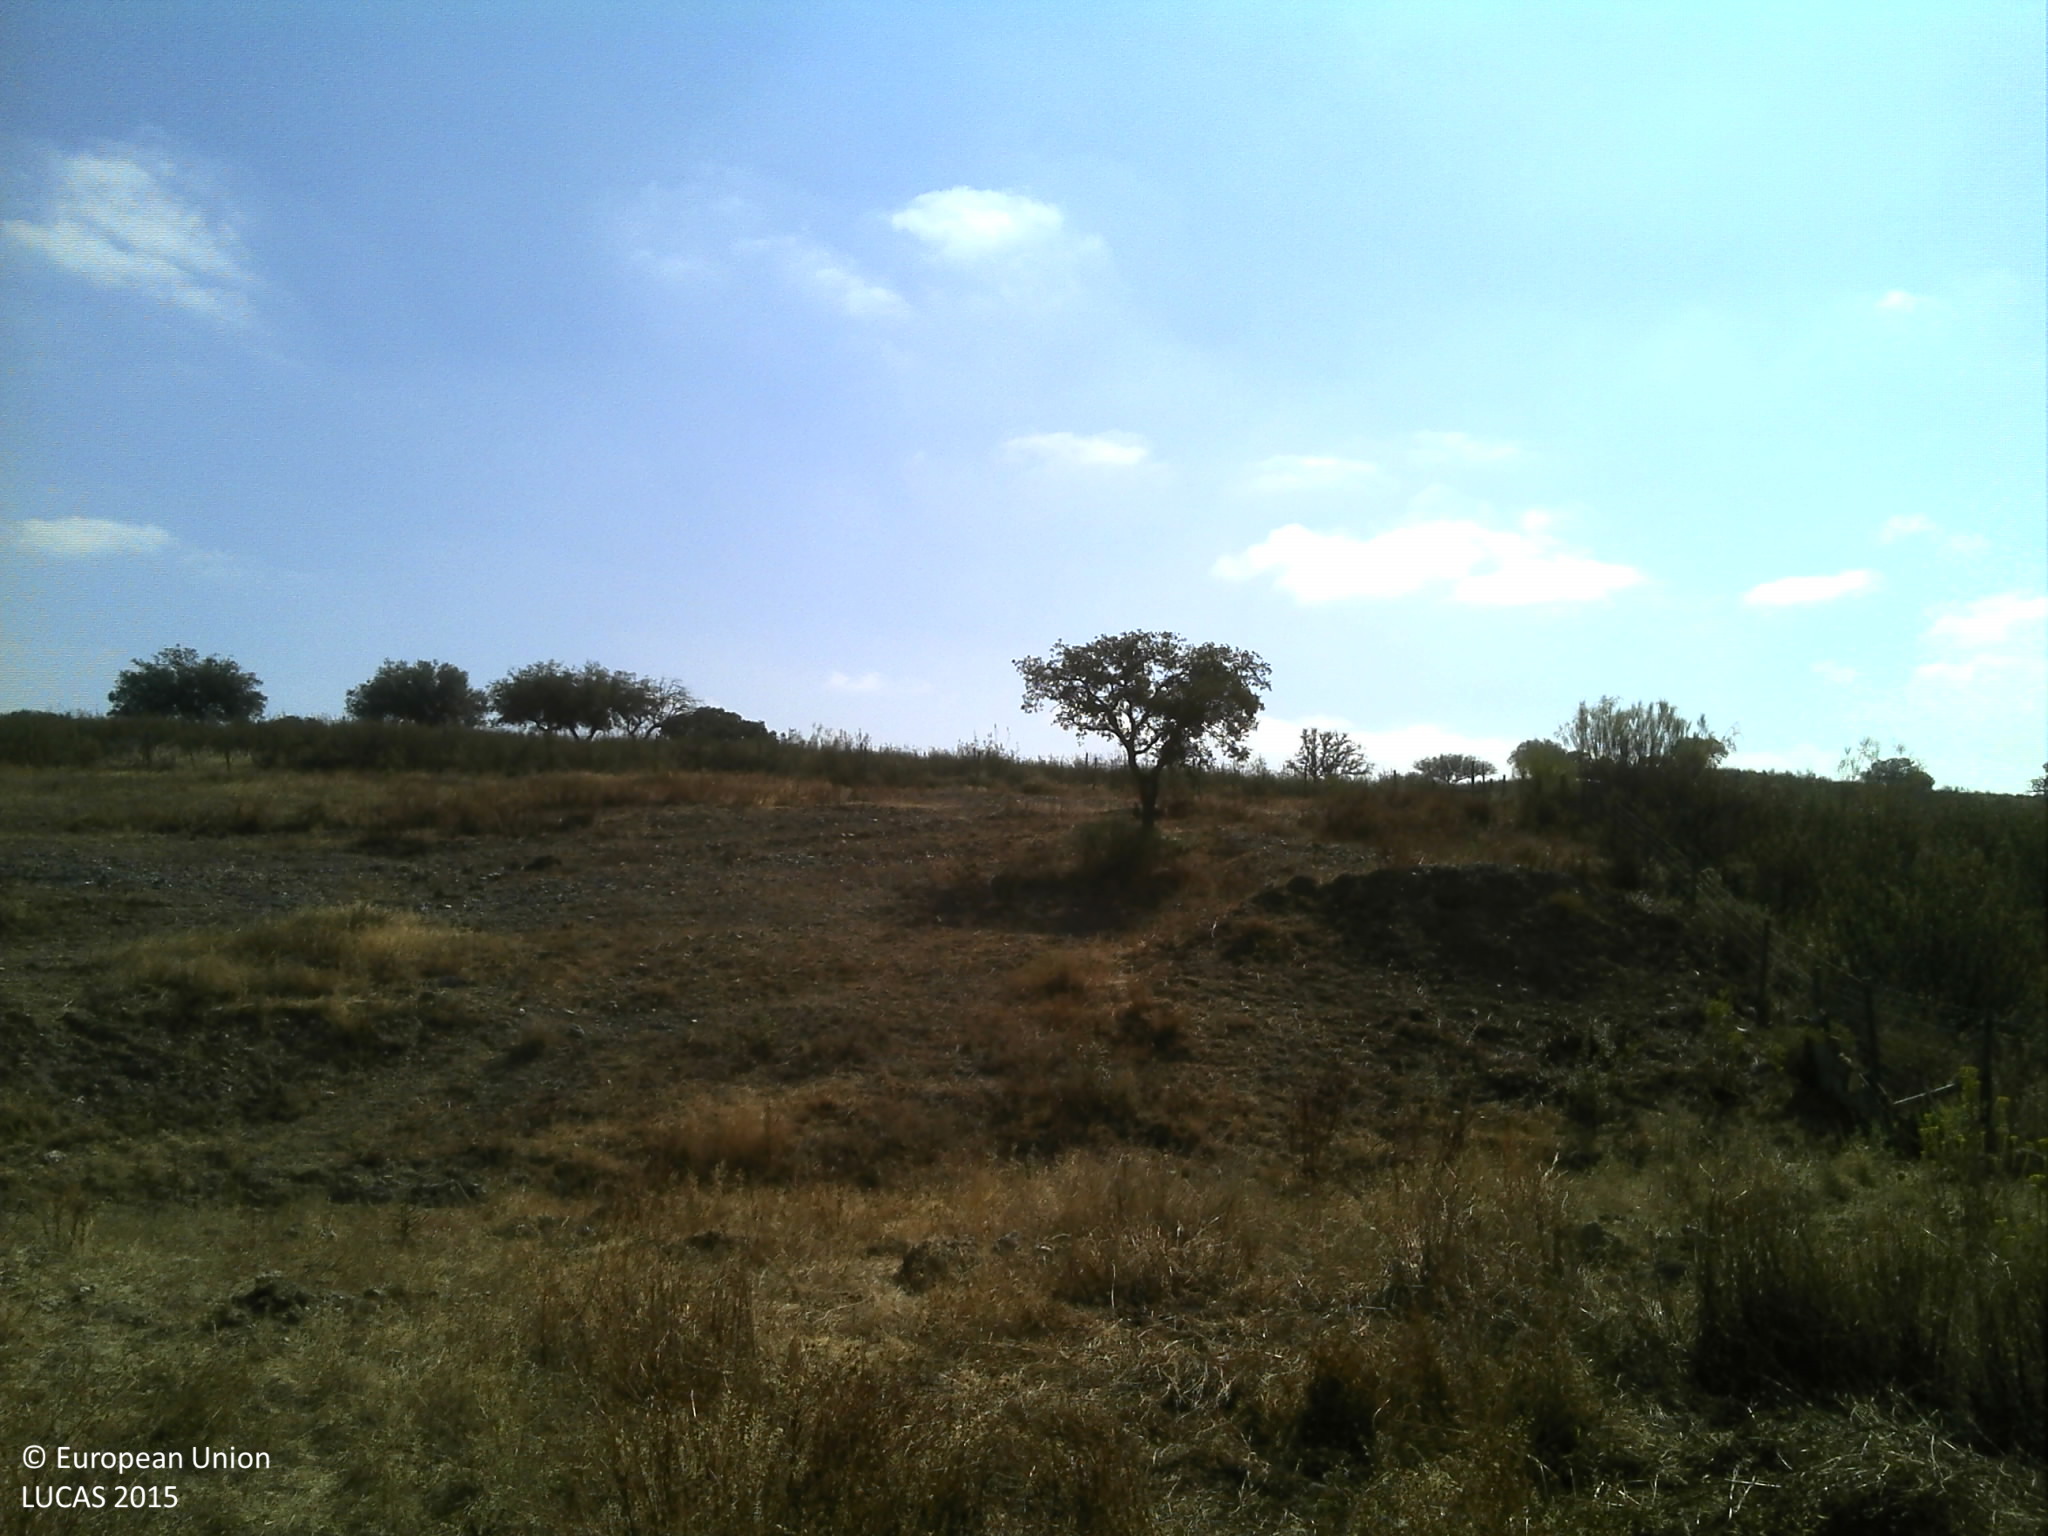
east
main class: Grassland
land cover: Grassland without tree/shrub cover
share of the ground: 25 - 50 %
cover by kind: unconsolidated bare surface 60 %, herbaceous plants 40 %
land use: Agriculture (excluding fallow land and kitchen gardens)
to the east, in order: Grassland without tree/shrub cover; Fences; Grassland without tree/shrub cover; Rivers and streams; Shrubland with sparse tree cover; Tracks; Shrubland with sparse tree cover; Fences; Shrubland without tree cover; Fences; Shruby margins; Other bare soil
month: July
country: PT
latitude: 38.4477
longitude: -7.3605
